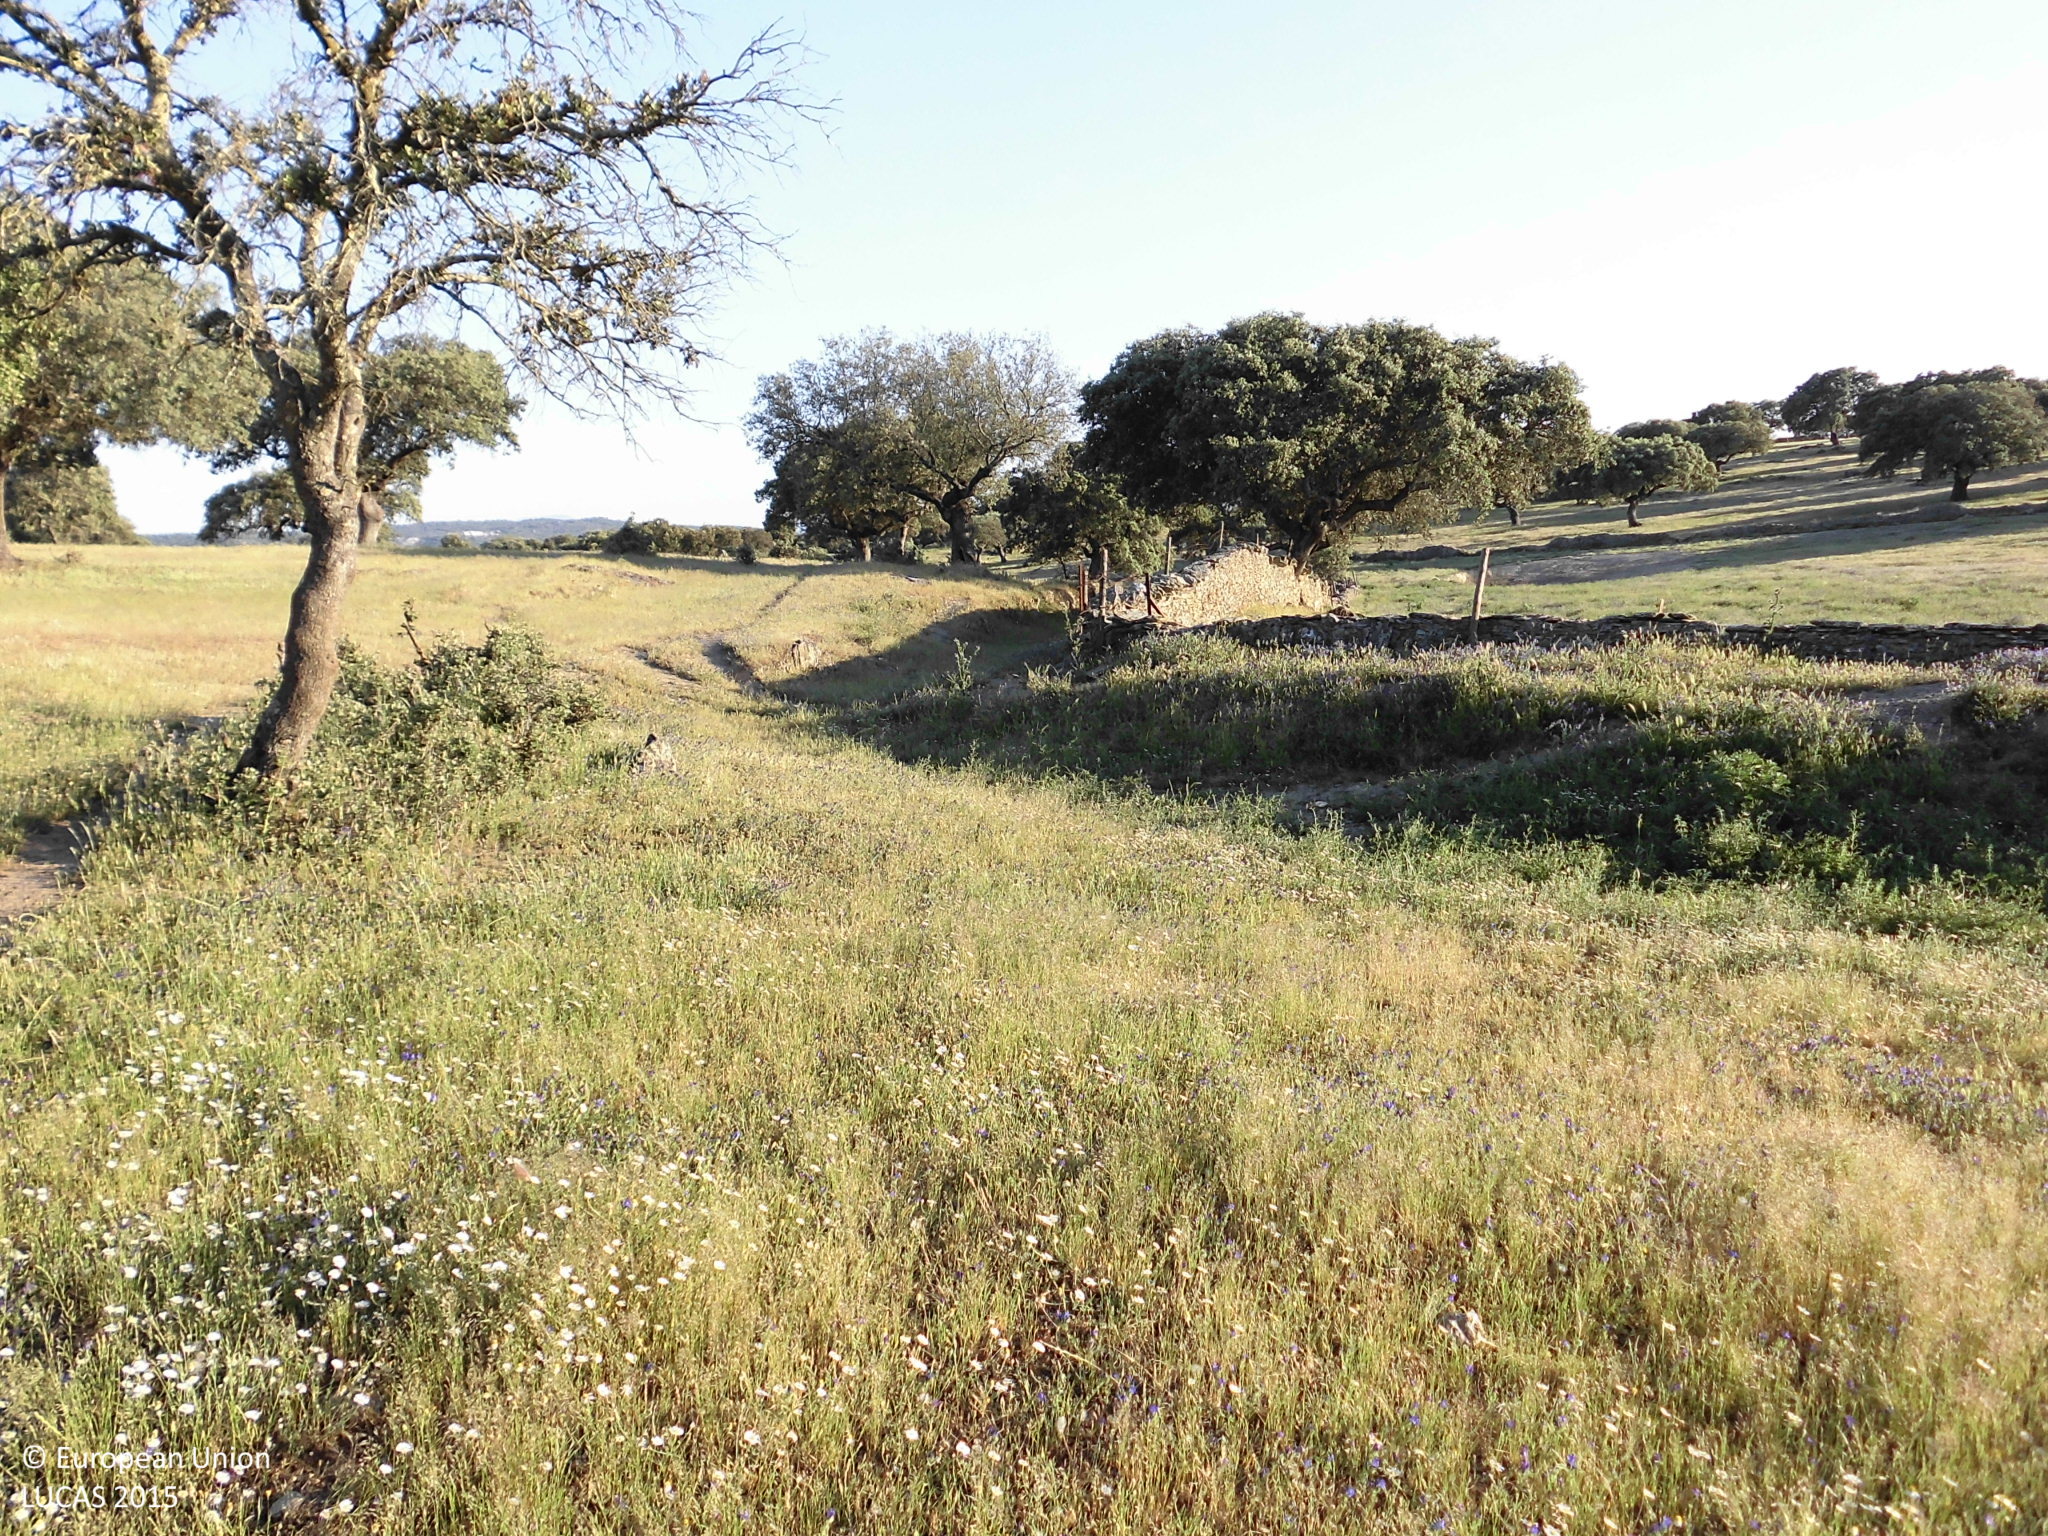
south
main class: Woodland
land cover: Broadleaved woodland
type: broadleaved evergreen forest
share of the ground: 10 - 25 %
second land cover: Grassland without tree/shrub cover
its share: > 75 %
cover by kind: herbaceous plants 85 %, broadleaved forest trees 15 %
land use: Forestry
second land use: Agriculture (excluding fallow land and kitchen gardens)
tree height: > 5 m
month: May
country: ES
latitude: 39.4671
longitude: -6.0673
